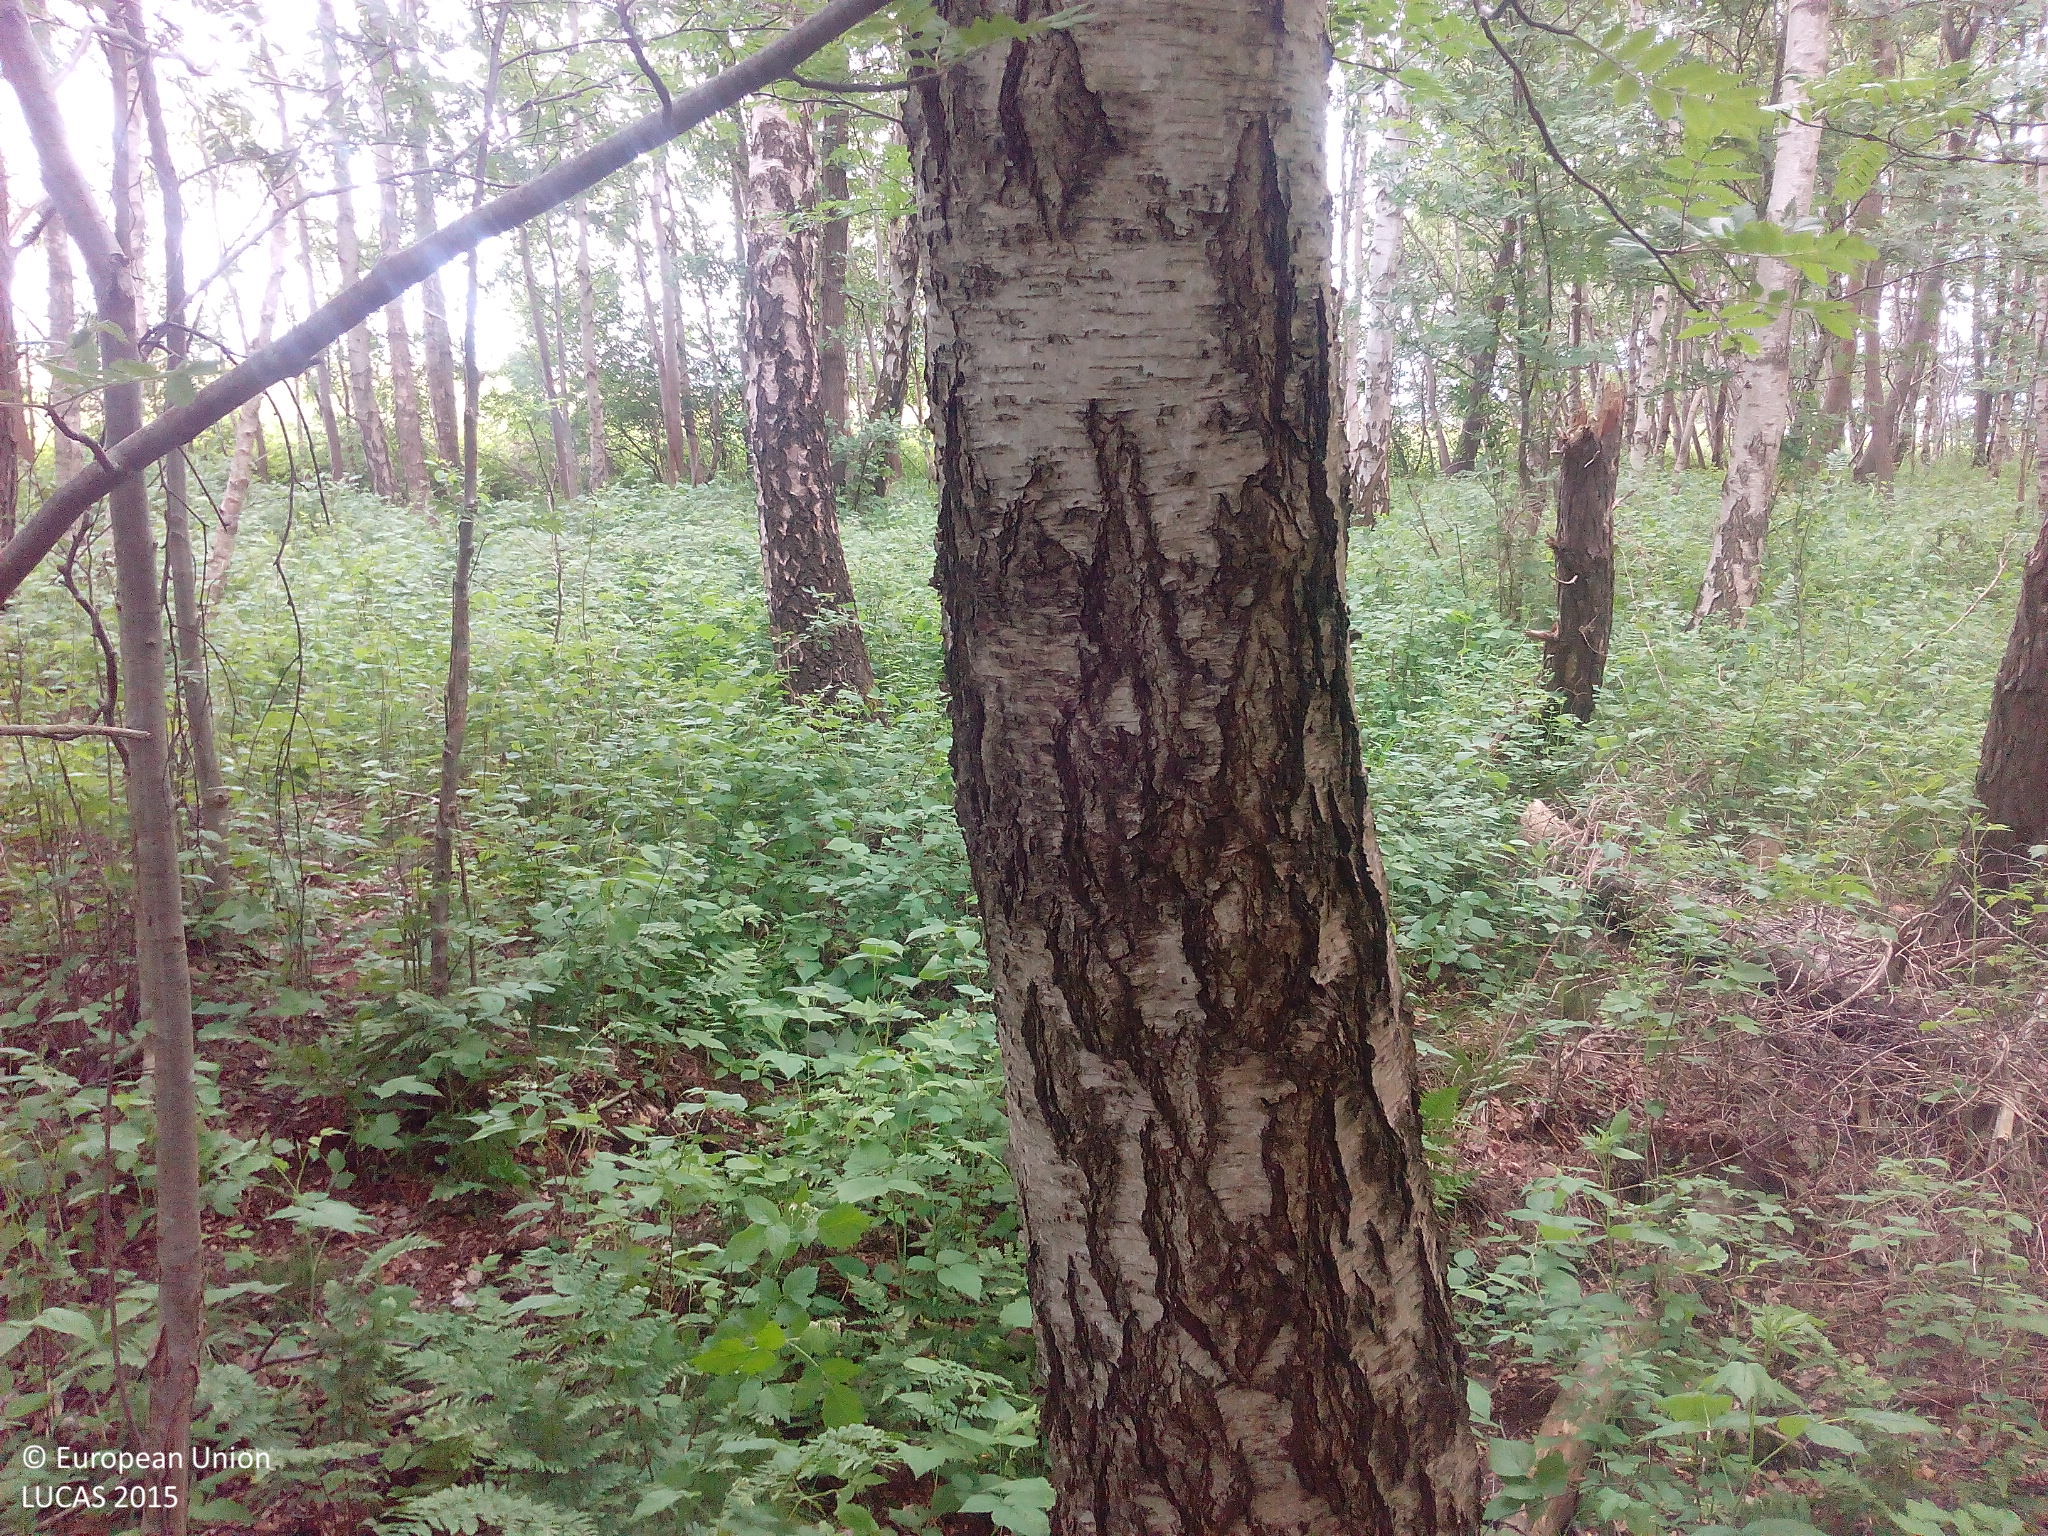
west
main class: Woodland
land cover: Broadleaved woodland
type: non-riverine alder, birch or aspen forest
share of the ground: > 75 %
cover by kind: broadleaved forest trees 90 %, coniferous forest trees 5 %, herbaceous plants 5 %
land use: Forestry
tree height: > 5 m
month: June
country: DE
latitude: 53.9732
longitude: 13.7655
